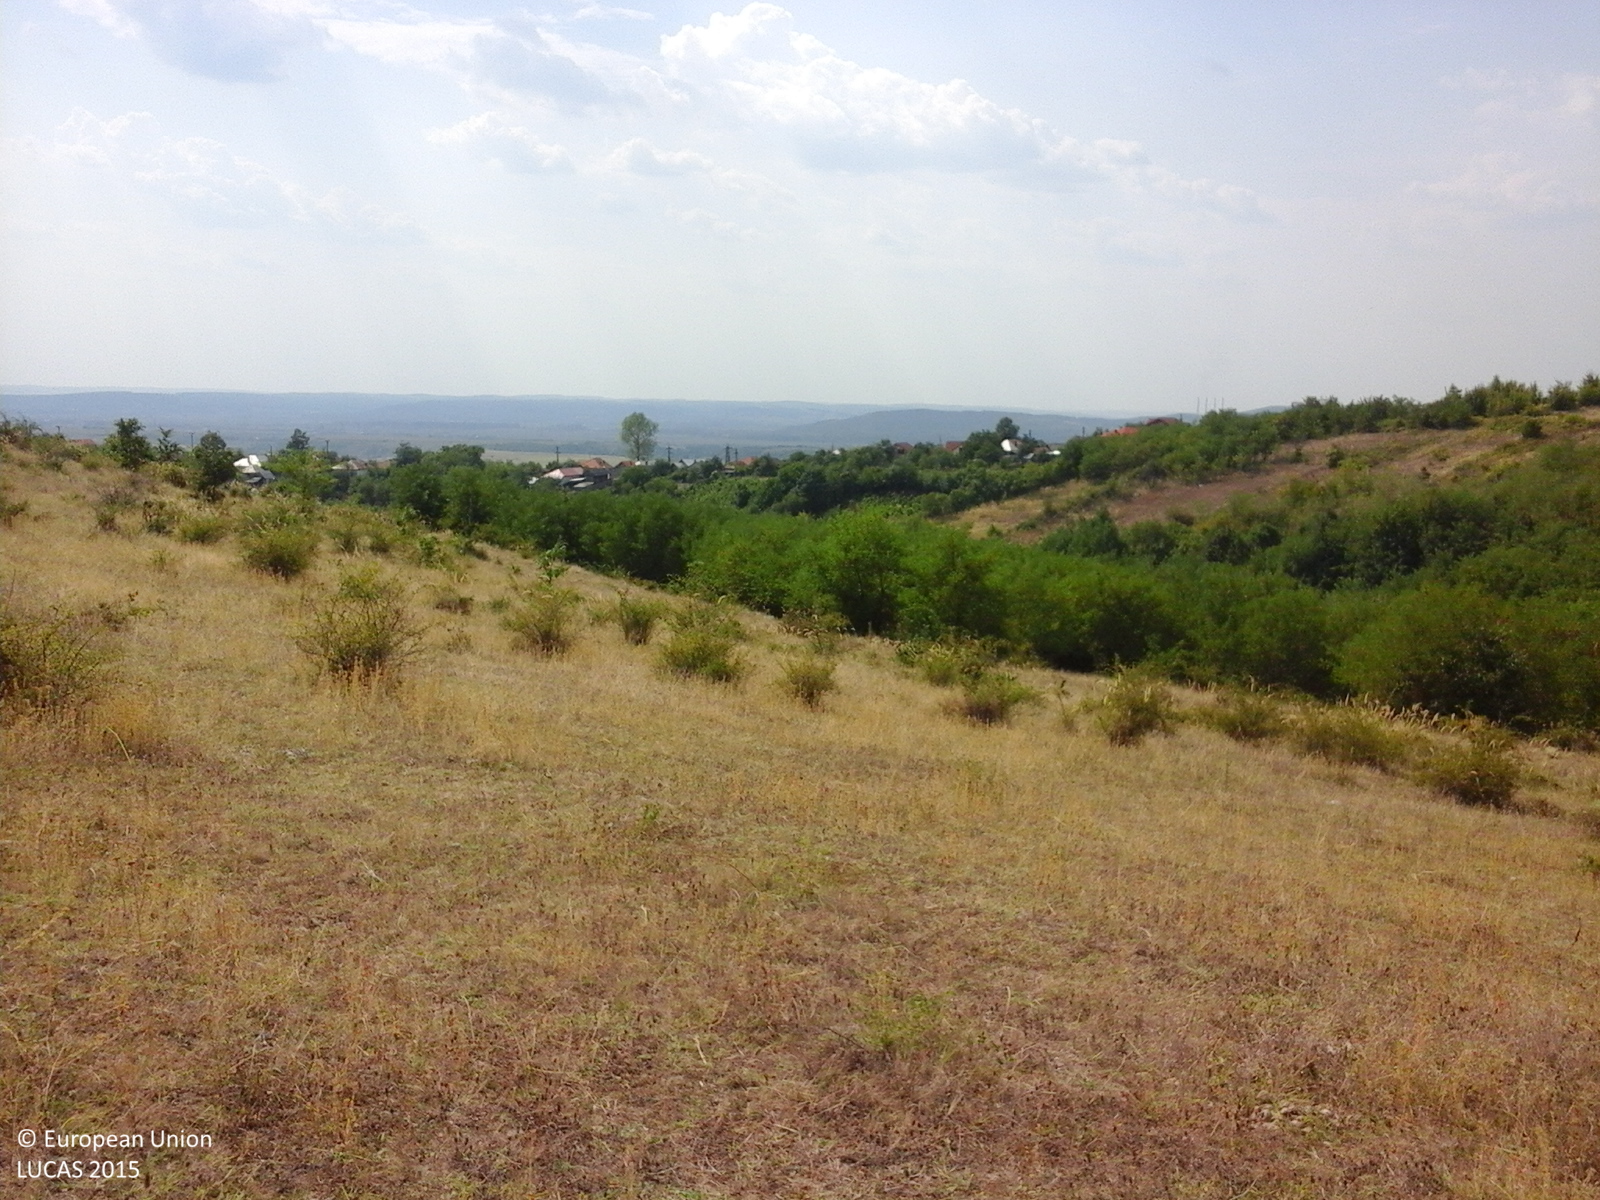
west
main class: Grassland
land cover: Grassland with sparse tree/shrub cover
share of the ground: > 75 %
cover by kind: herbaceous plants 85 %, shrubs 10 %, broadleaved forest trees 5 %
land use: Agriculture (excluding fallow land and kitchen gardens)
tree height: < 5 m
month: August
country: RO
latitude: 44.6223
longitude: 23.5790
